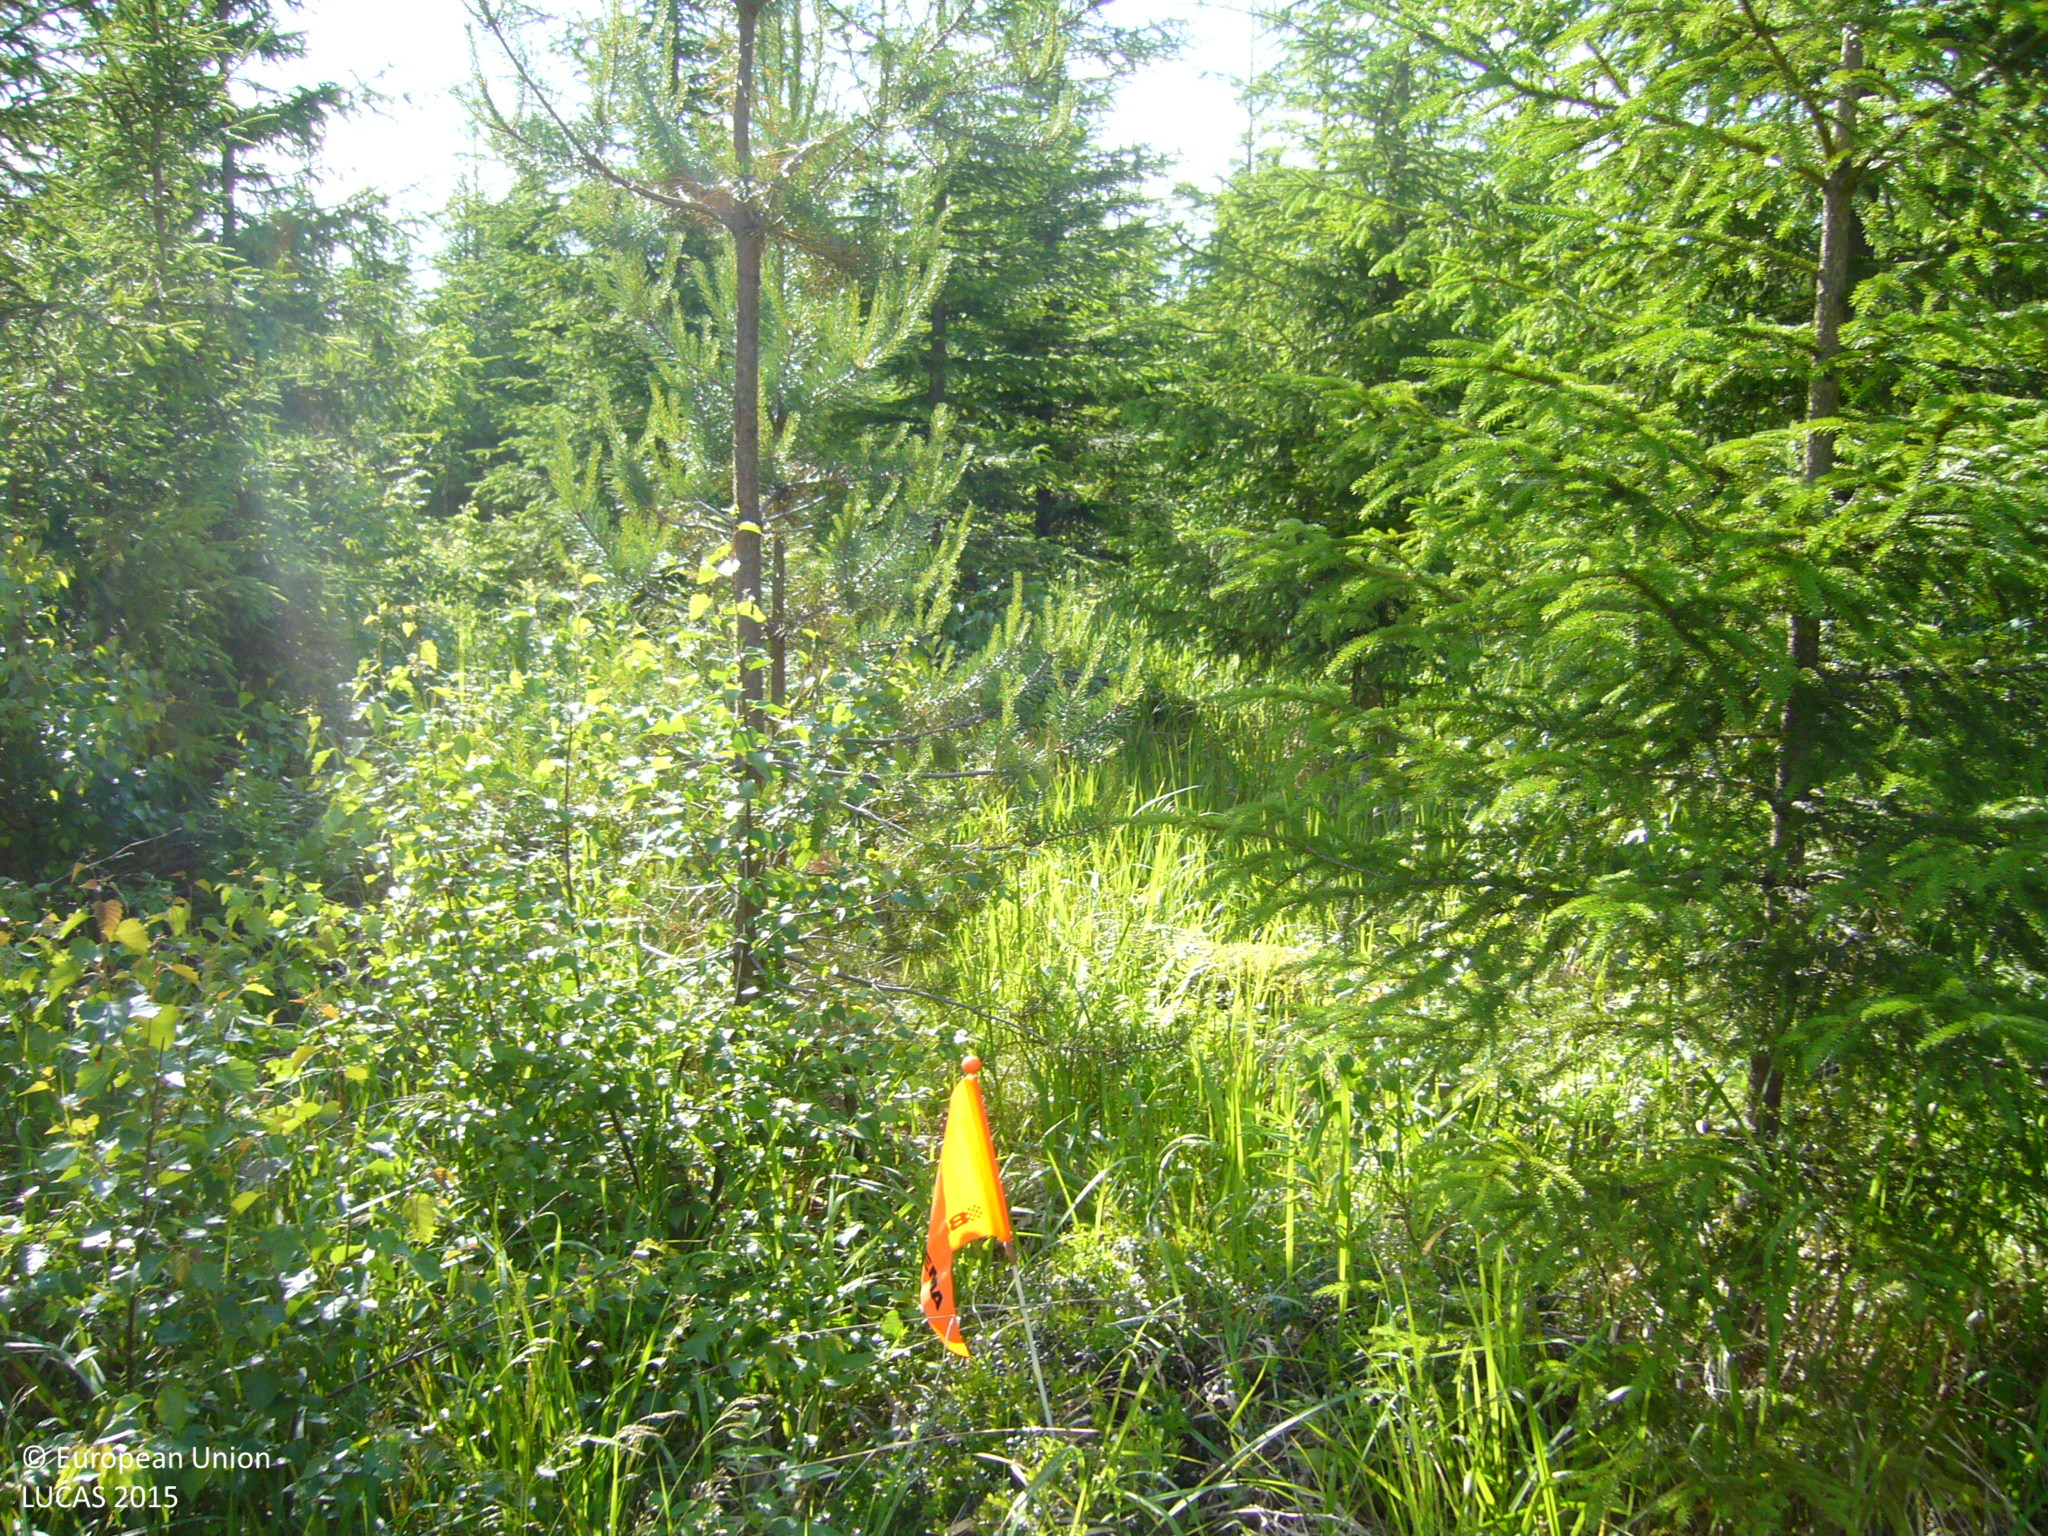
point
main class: Woodland
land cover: Spruce dominated coniferous woodland
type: boreal forest
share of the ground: 50 - 75 %
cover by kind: coniferous forest trees 50 %, shrubs 50 %
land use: Forestry
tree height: < 5 m
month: July
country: FI
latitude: 63.3825
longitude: 26.1020
